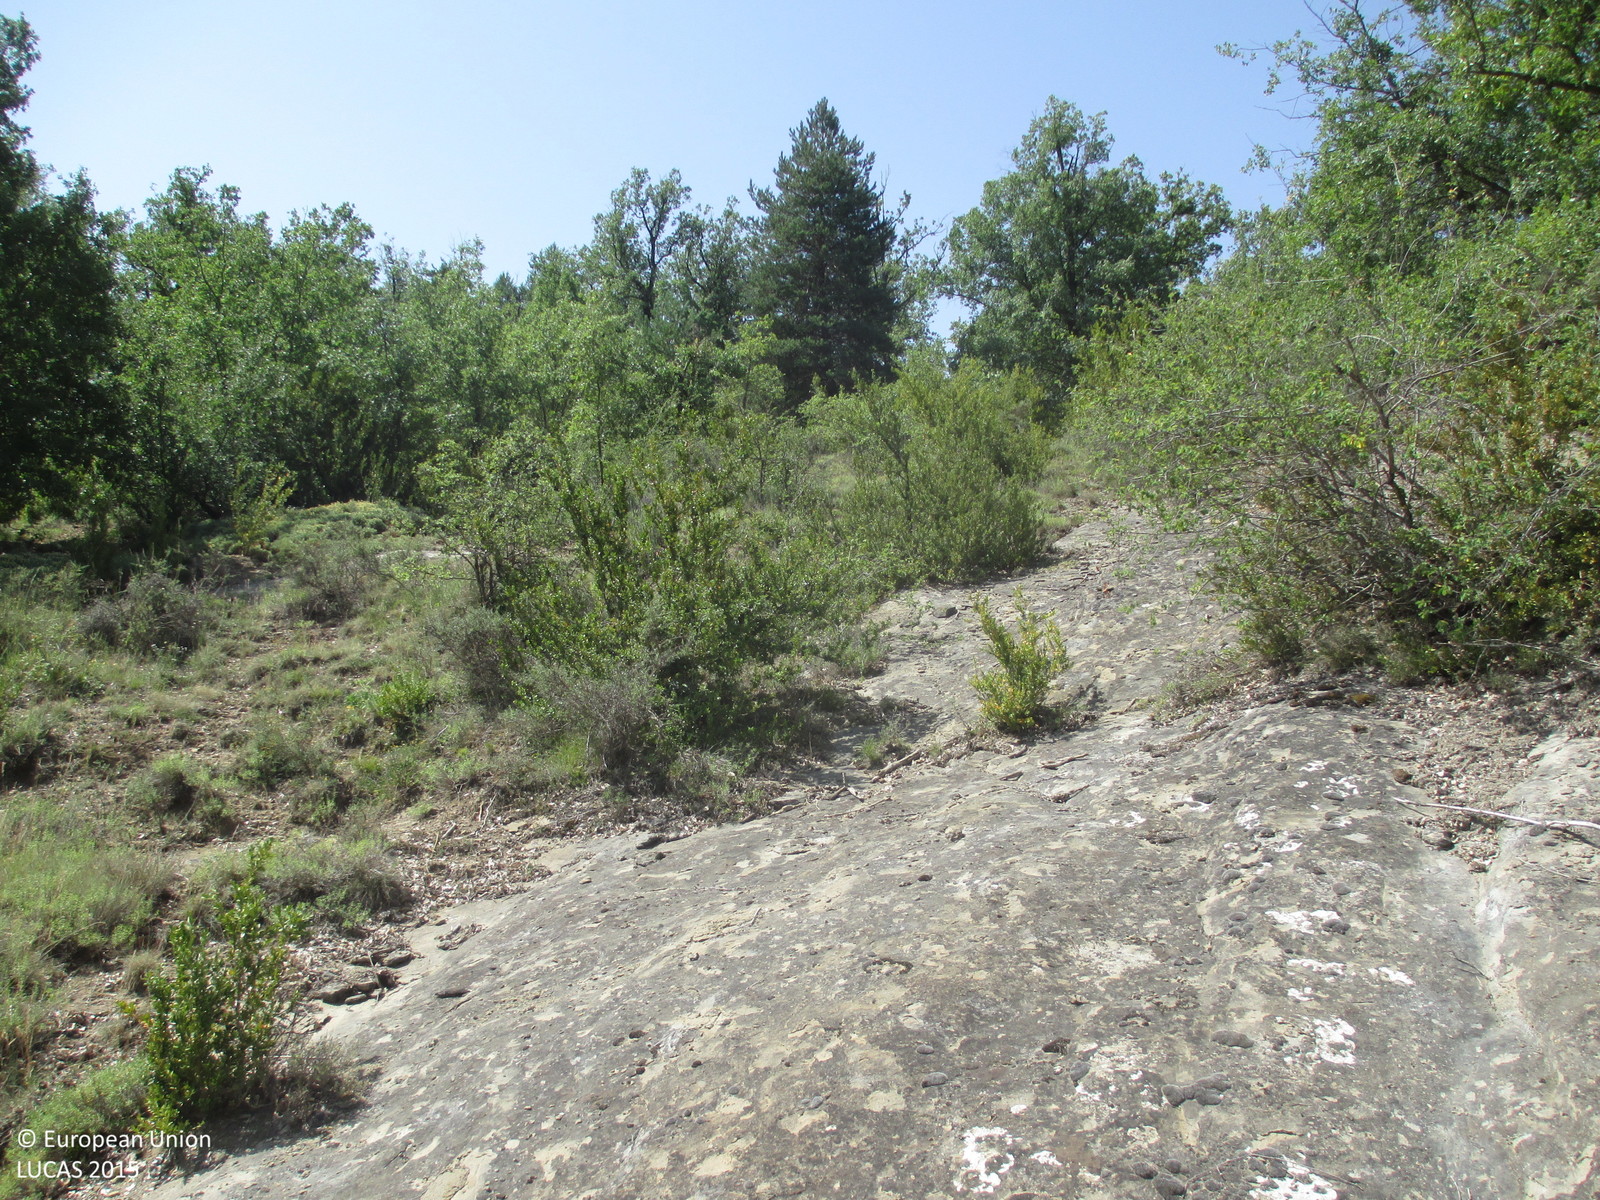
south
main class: Grassland
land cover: Grassland with sparse tree/shrub cover
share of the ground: > 75 %
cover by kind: herbaceous plants 85 %, coniferous forest trees 5 %, shrubs 5 %, consolidated bare surface 5 %
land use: Semi-natural and natural areas not in use
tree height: > 5 m
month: July
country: ES
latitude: 42.3712
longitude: -0.4073
